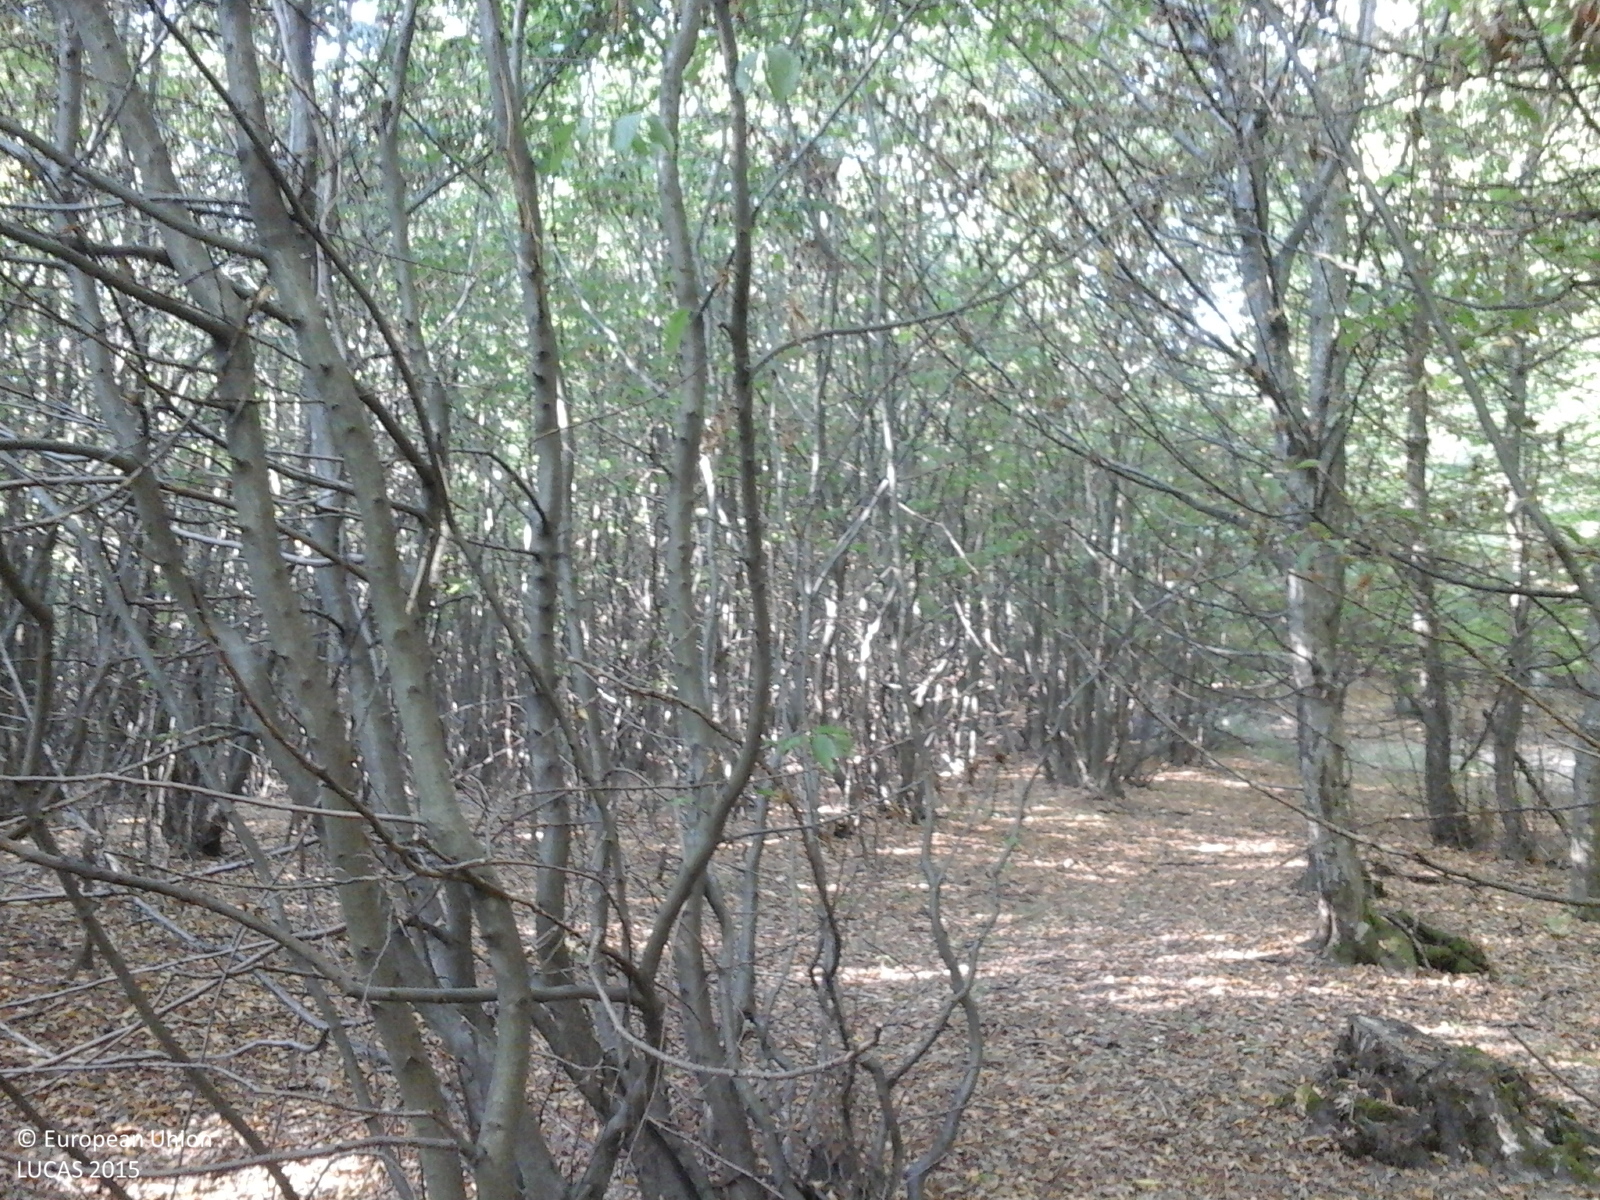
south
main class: Woodland
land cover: Broadleaved woodland
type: beech forest
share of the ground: > 75 %
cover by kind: broadleaved forest trees 100 %
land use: Forestry
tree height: > 5 m
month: September
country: RO
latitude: 46.8803
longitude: 24.4570
